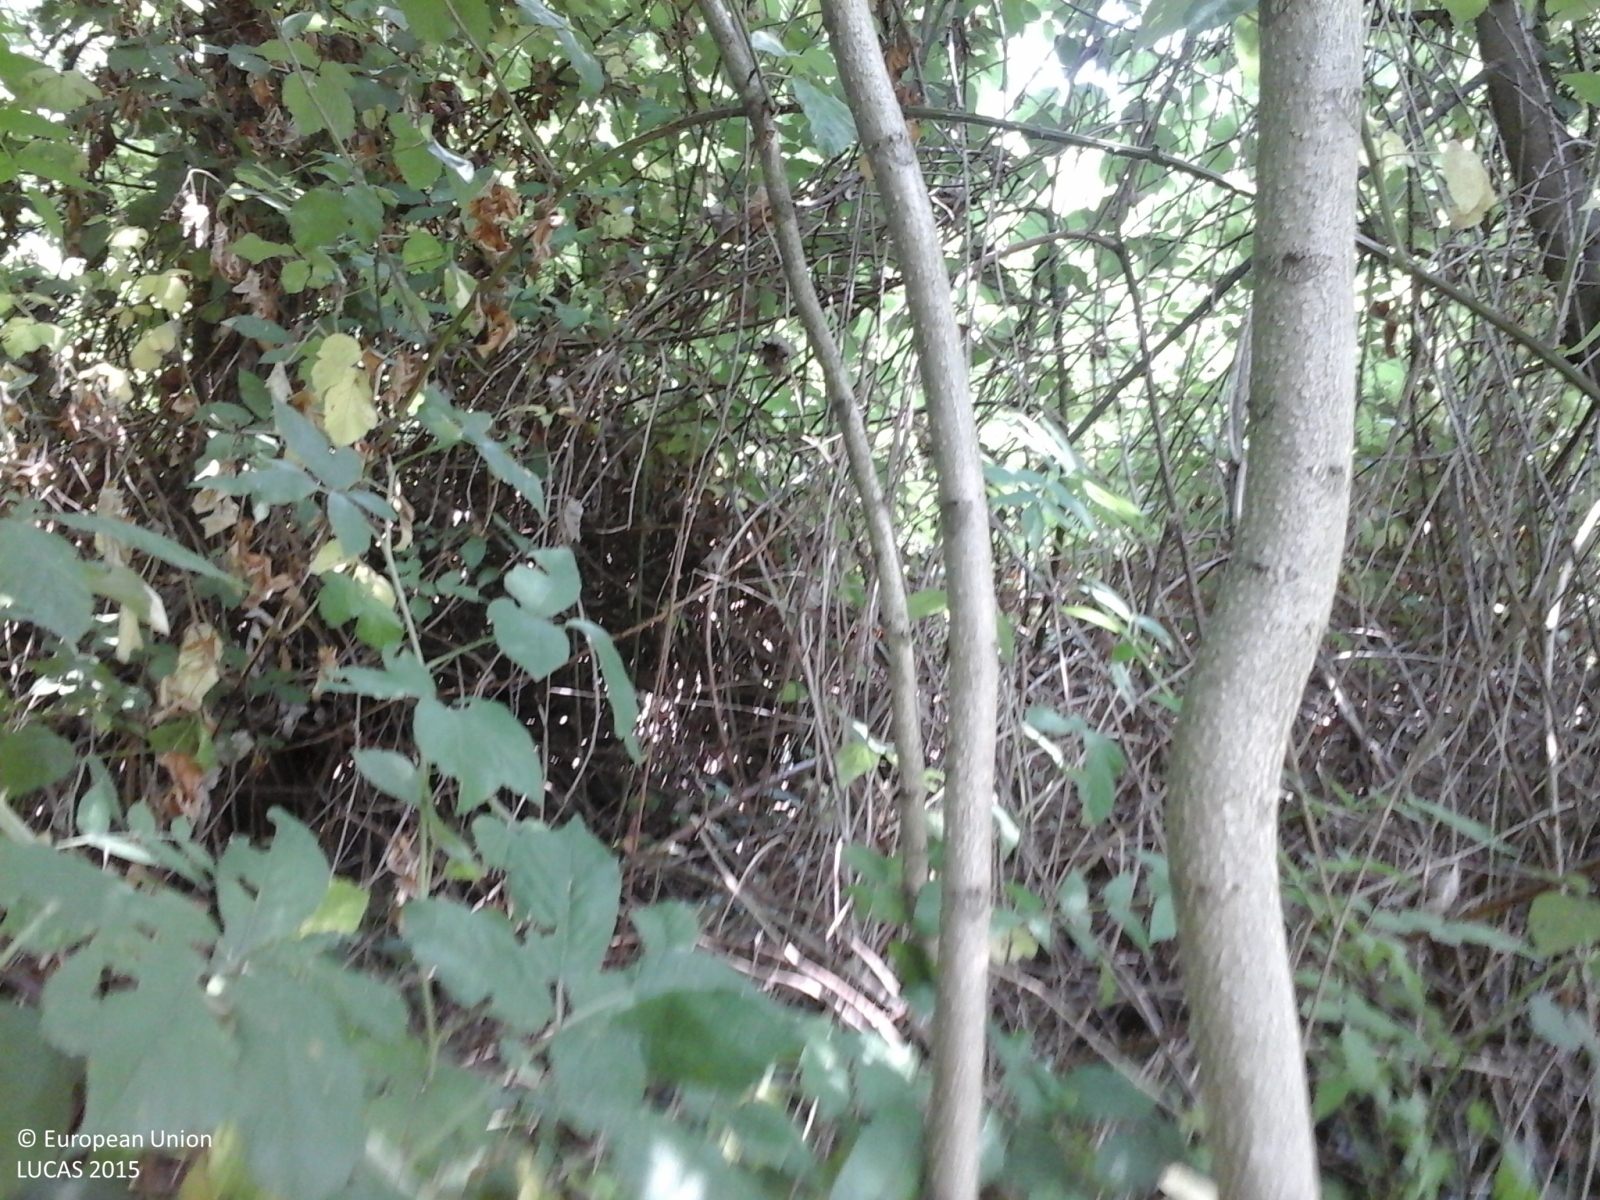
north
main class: Woodland
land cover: Broadleaved woodland
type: thermophilous deciduous forest
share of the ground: > 75 %
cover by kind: broadleaved forest trees 100 %
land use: Semi-natural and natural areas not in use
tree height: > 5 m
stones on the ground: 10 - 25 %
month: July
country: IT
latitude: 45.0839
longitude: 7.7553
